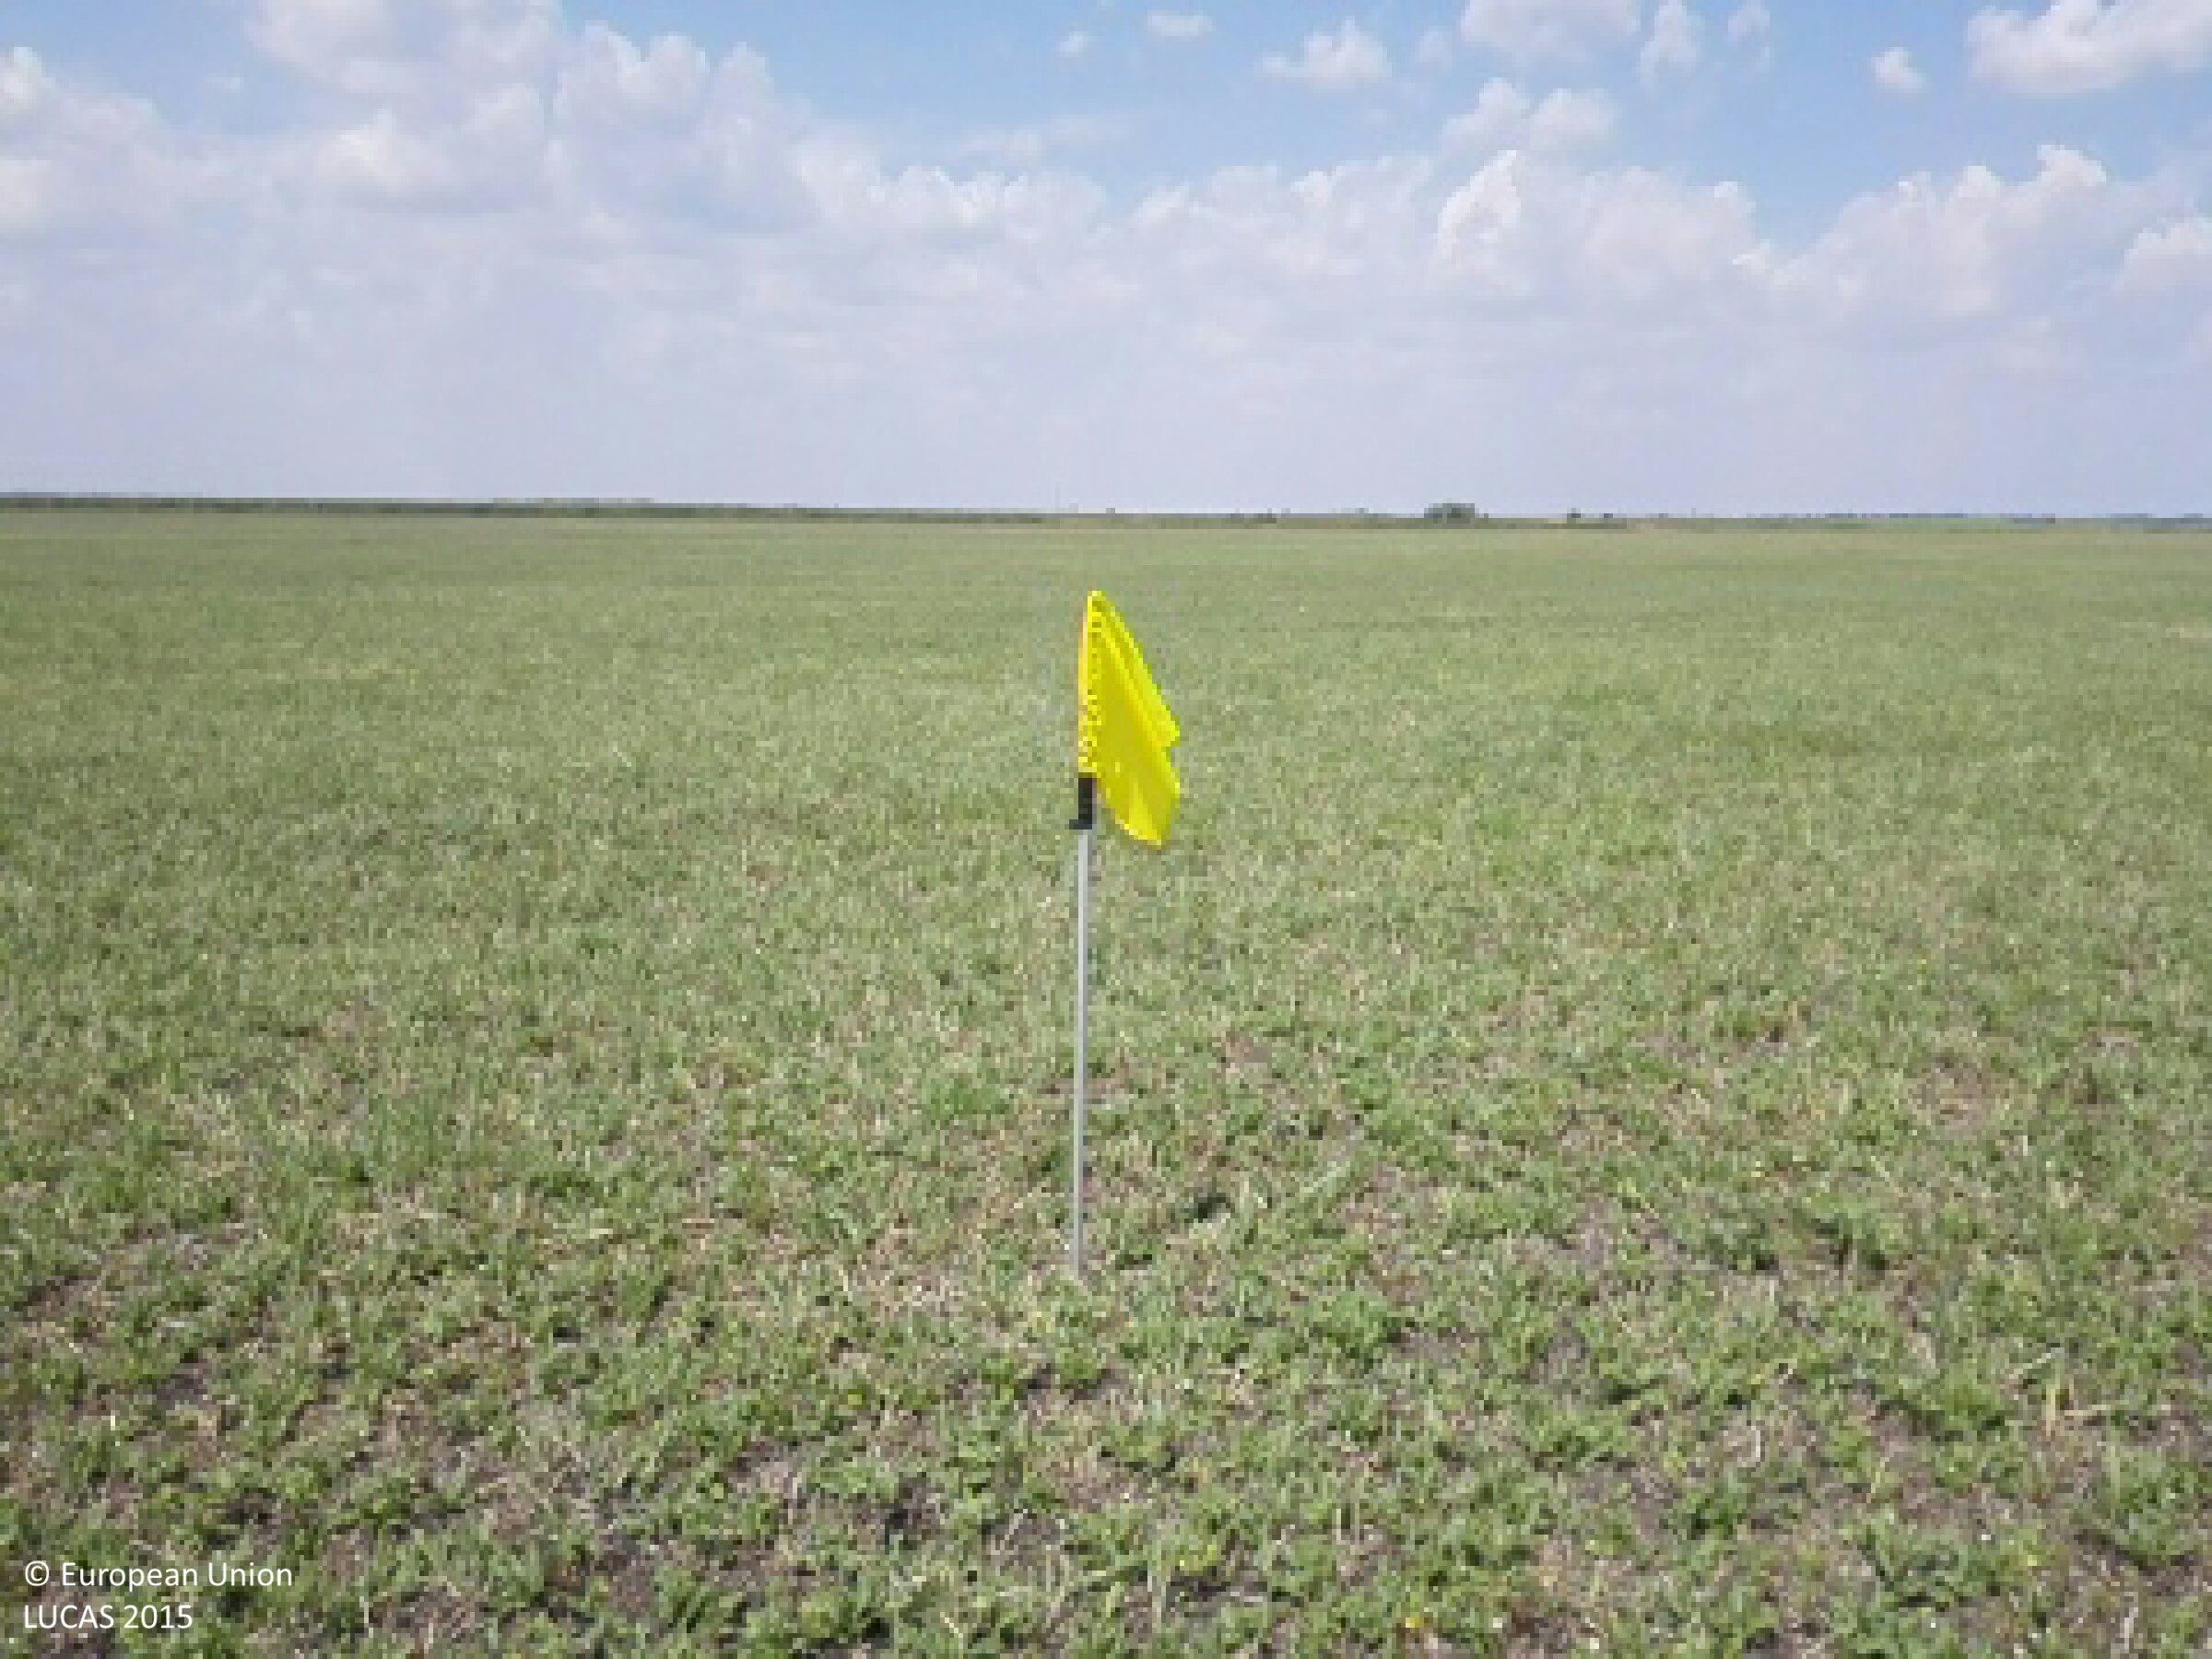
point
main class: Cropland
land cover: Other fibre and oleaginous crops
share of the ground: 50 - 75 %
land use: Agriculture (excluding fallow land and kitchen gardens)
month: July
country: HU
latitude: 47.2960
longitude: 21.2930
